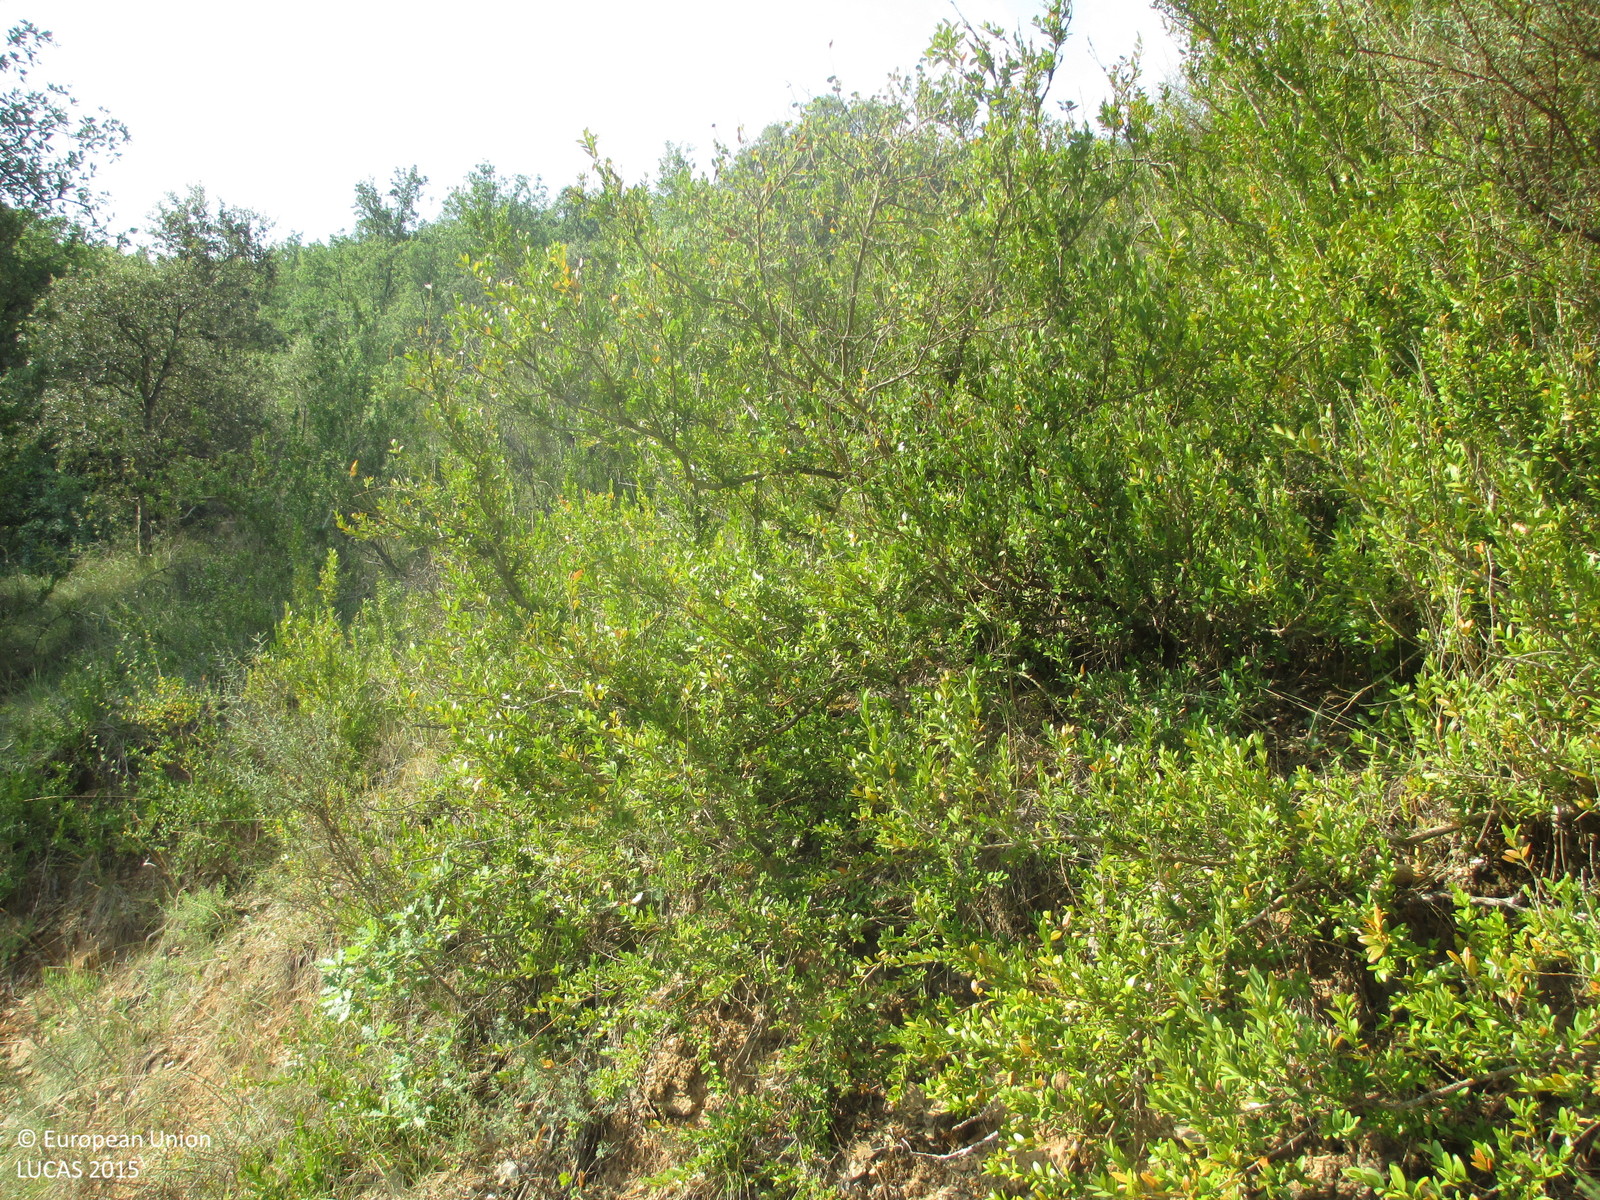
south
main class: Woodland
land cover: Broadleaved woodland
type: broadleaved evergreen forest
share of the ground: > 75 %
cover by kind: broadleaved forest trees 95 %, shrubs 5 %
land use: Semi-natural and natural areas not in use
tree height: < 5 m
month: July
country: ES
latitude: 42.1032
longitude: 0.3692
